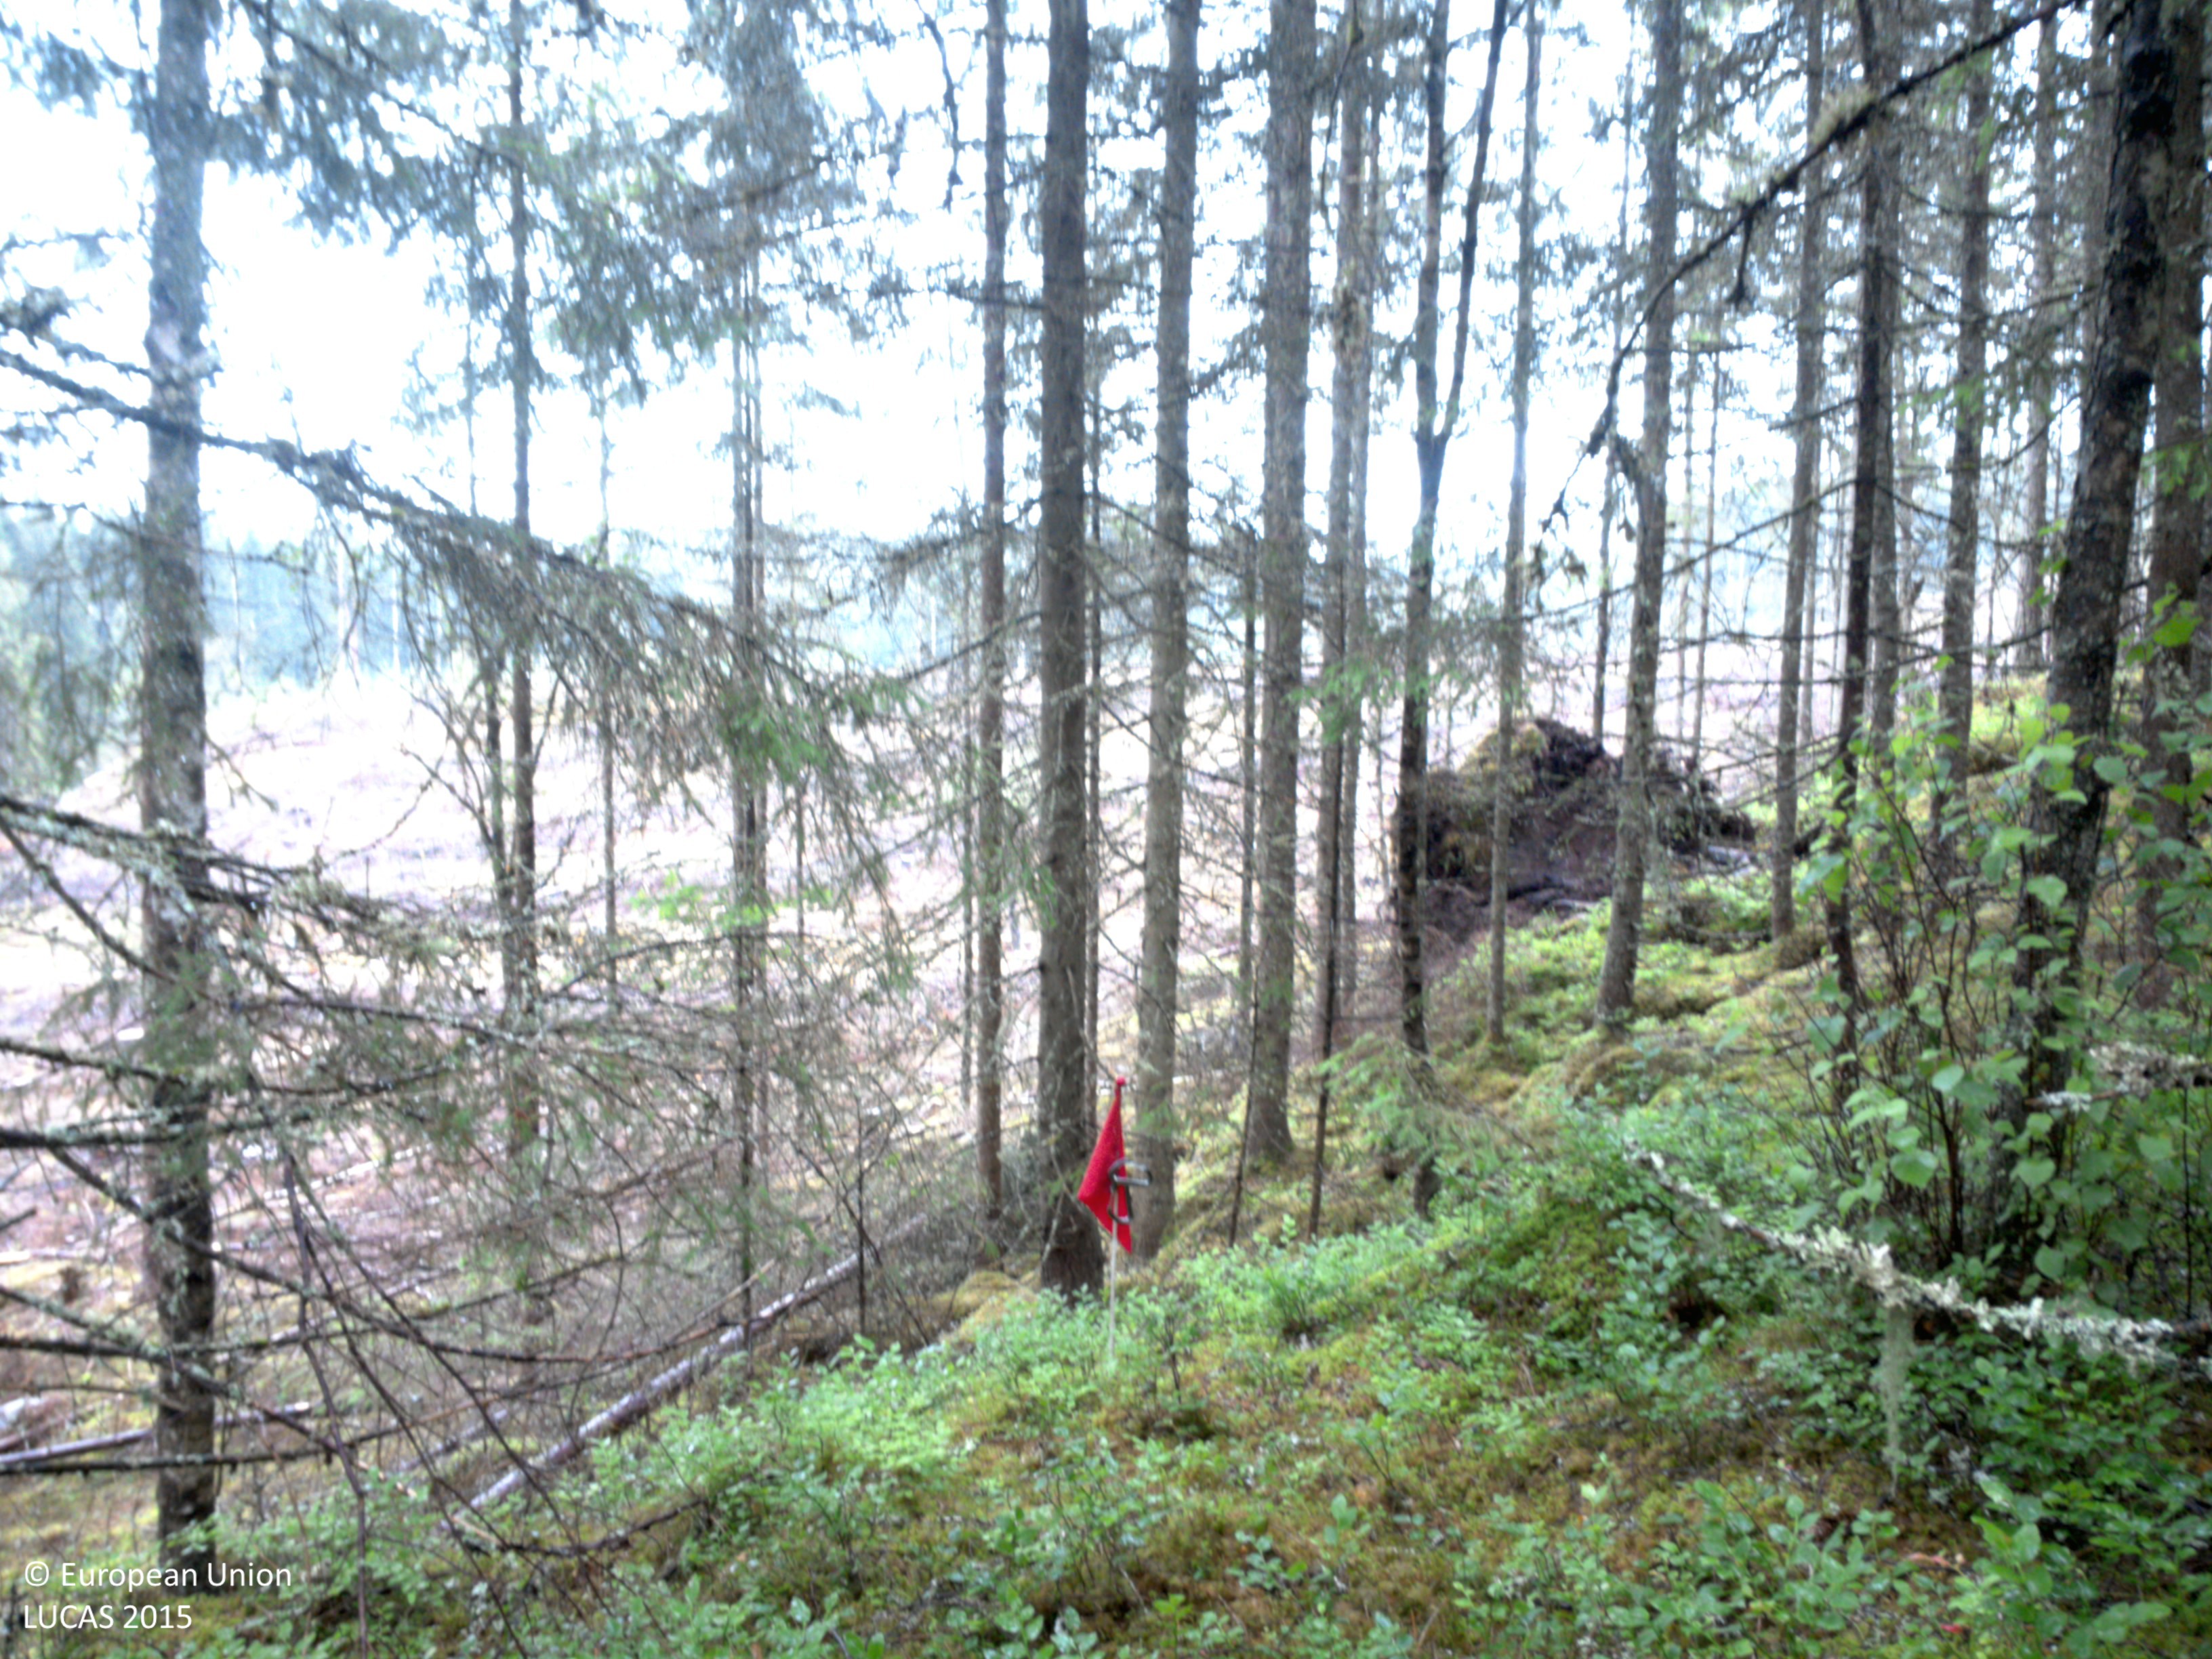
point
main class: Woodland
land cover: Spruce dominated coniferous woodland
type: boreal forest
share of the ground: 50 - 75 %
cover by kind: coniferous forest trees 70 %, lichens and mosses 20 %, shrubs 10 %
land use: Forestry
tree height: > 5 m
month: July
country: SE
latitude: 58.6957
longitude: 11.6012
